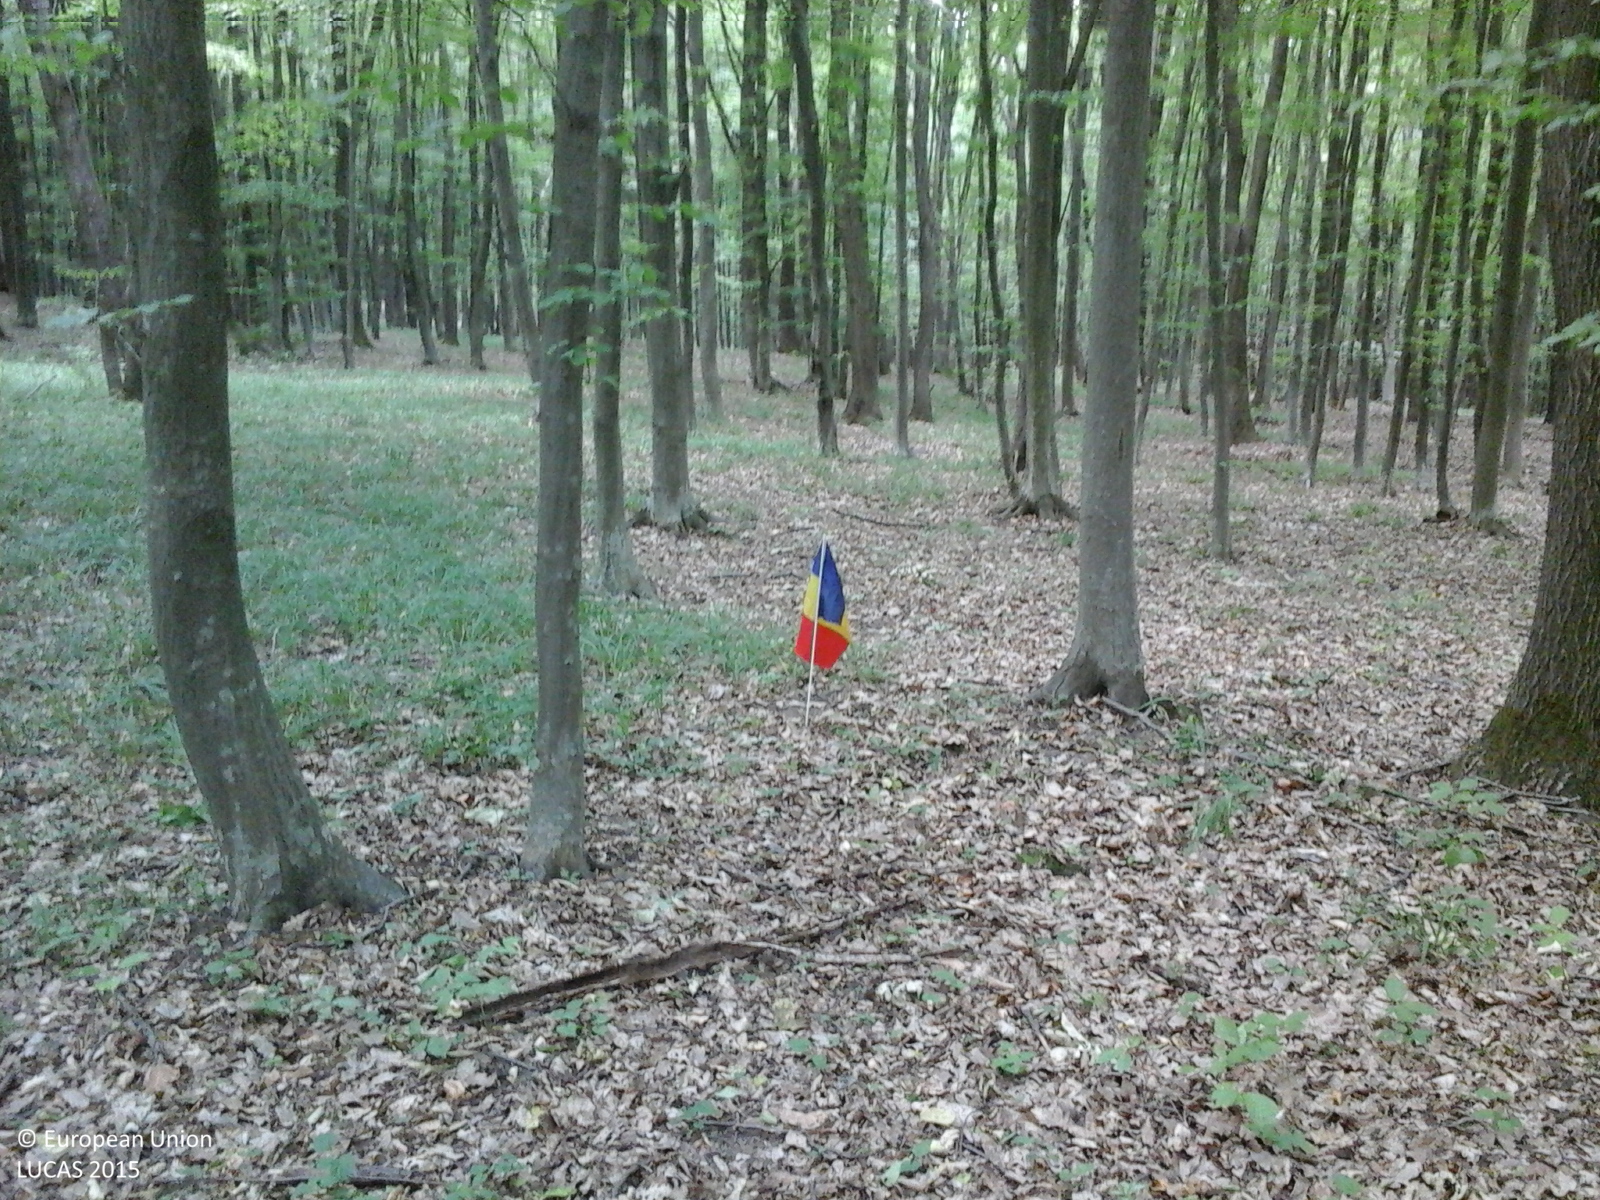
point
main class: Woodland
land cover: Broadleaved woodland
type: beech forest
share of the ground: > 75 %
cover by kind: broadleaved forest trees 95 %, herbaceous plants 5 %
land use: Forestry
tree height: > 5 m
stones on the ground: < 10 %
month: June
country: RO
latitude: 47.8543
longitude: 26.3524
